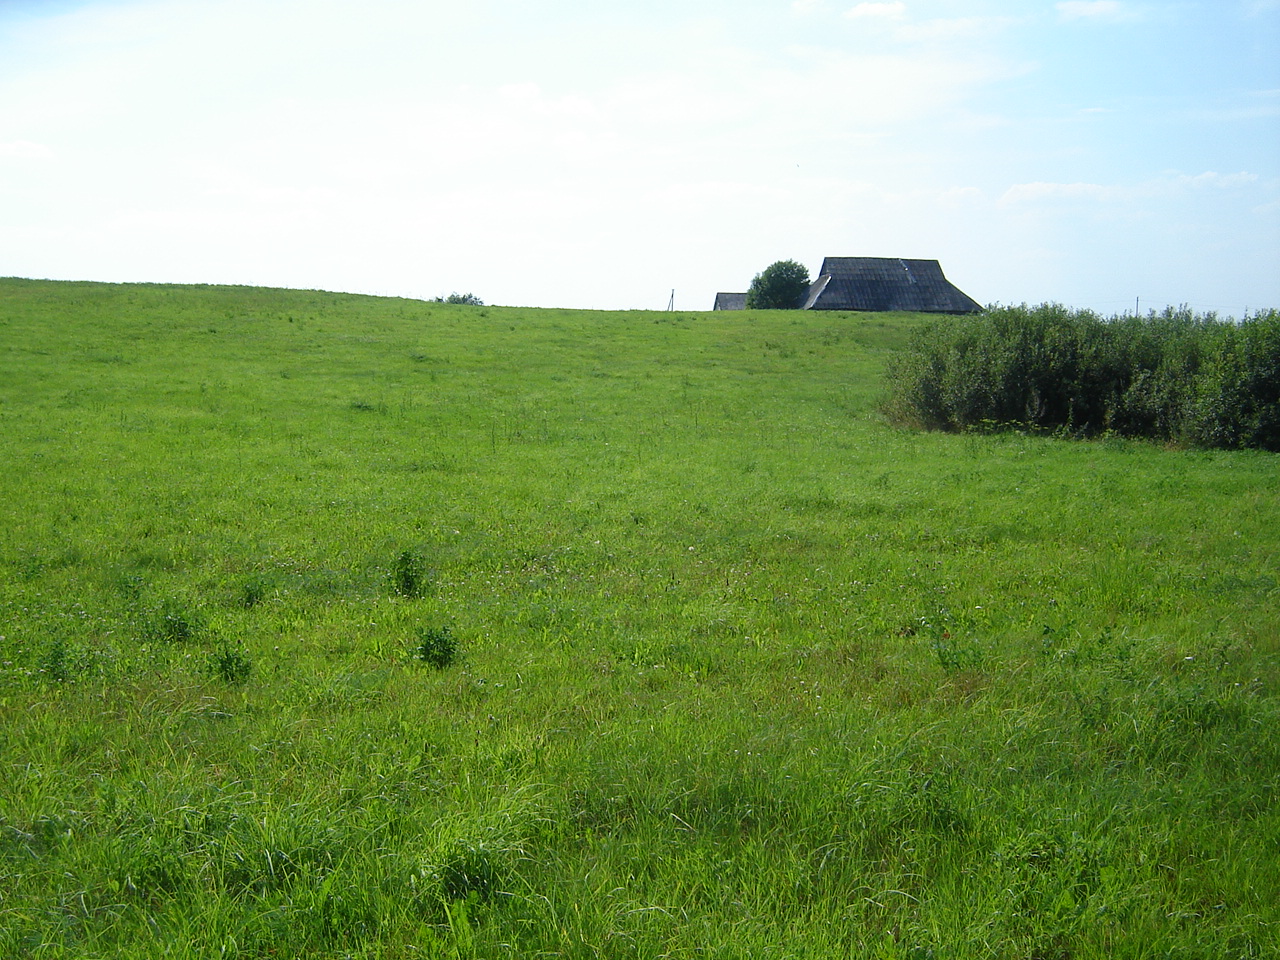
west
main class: Grassland
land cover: Grassland without tree/shrub cover
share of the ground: > 75 %
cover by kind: herbaceous plants 100 %
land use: Agriculture (excluding fallow land and kitchen gardens)
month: August
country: LT
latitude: 55.1553
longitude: 24.9743
